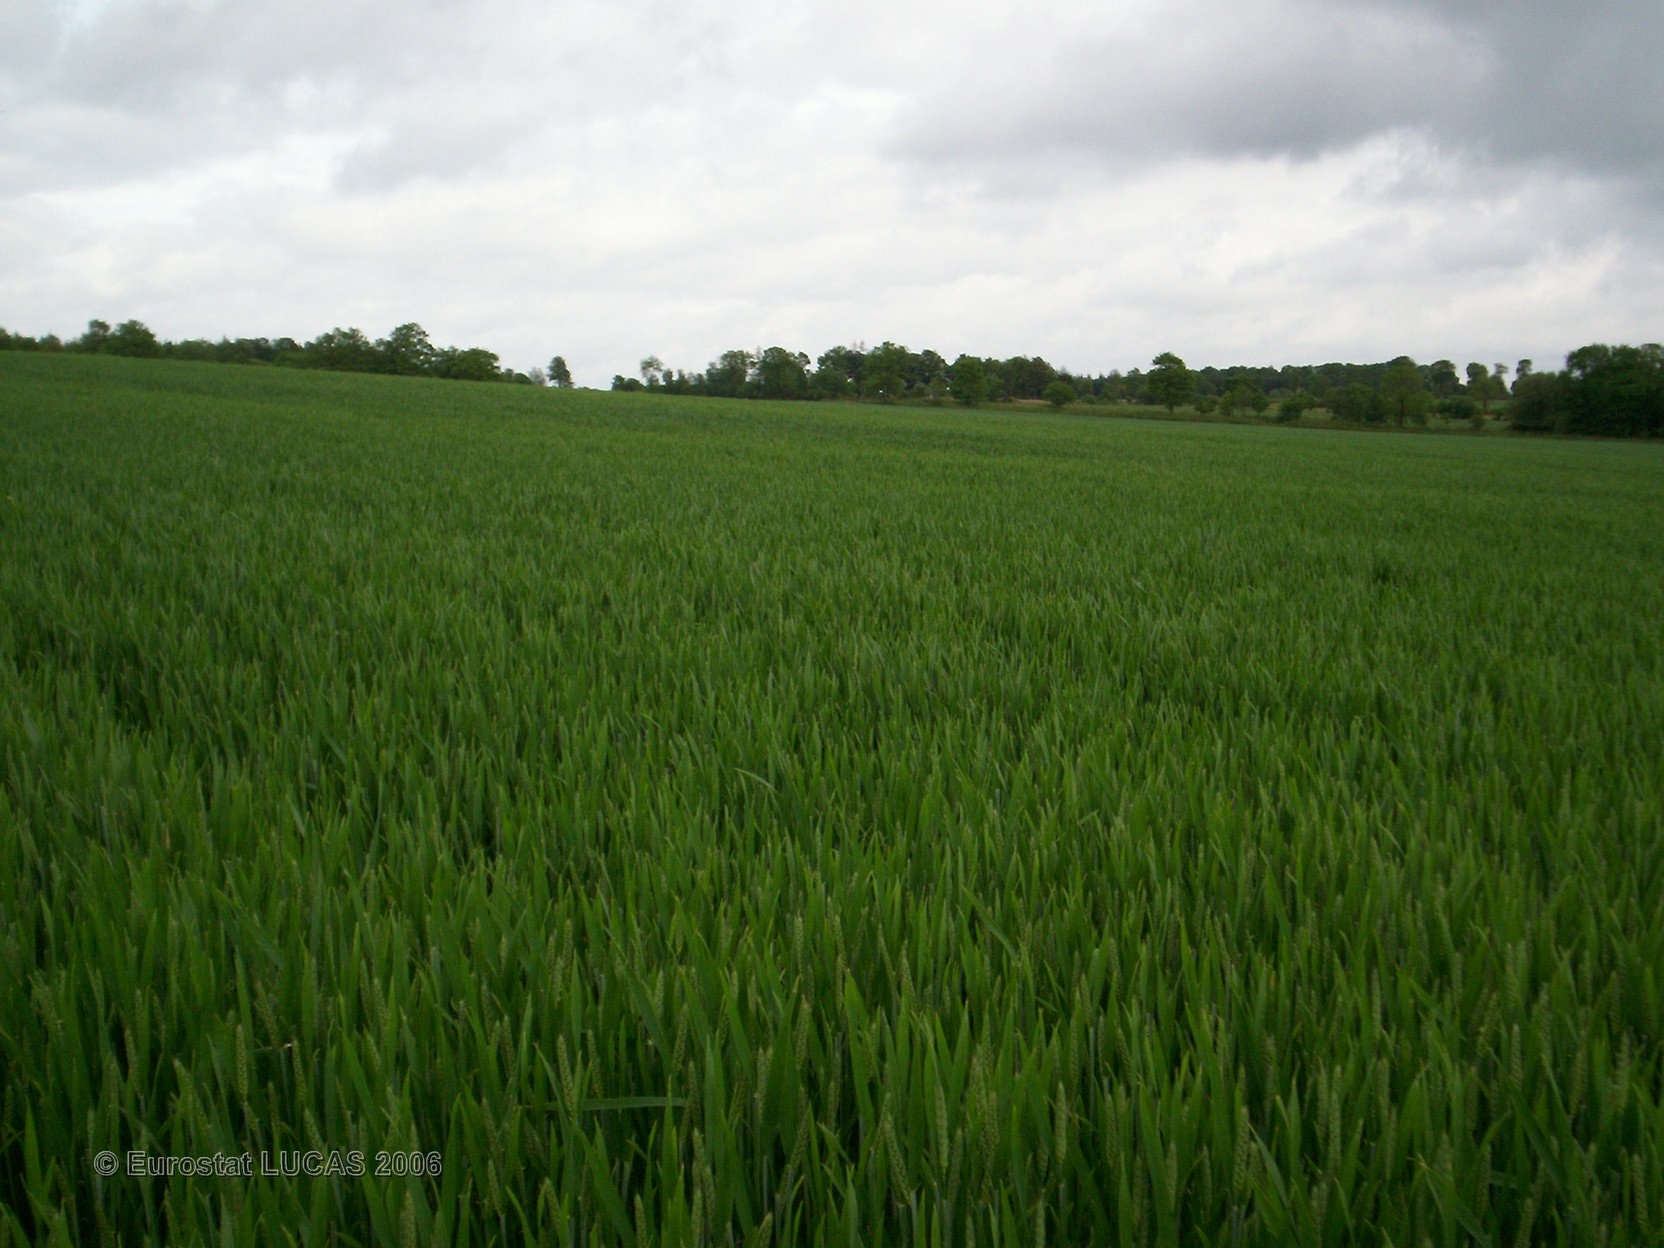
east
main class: Cropland
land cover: Common wheat
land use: Agriculture (excluding fallow land and kitchen gardens)
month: May
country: FR
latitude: 48.2090
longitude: -2.4263
